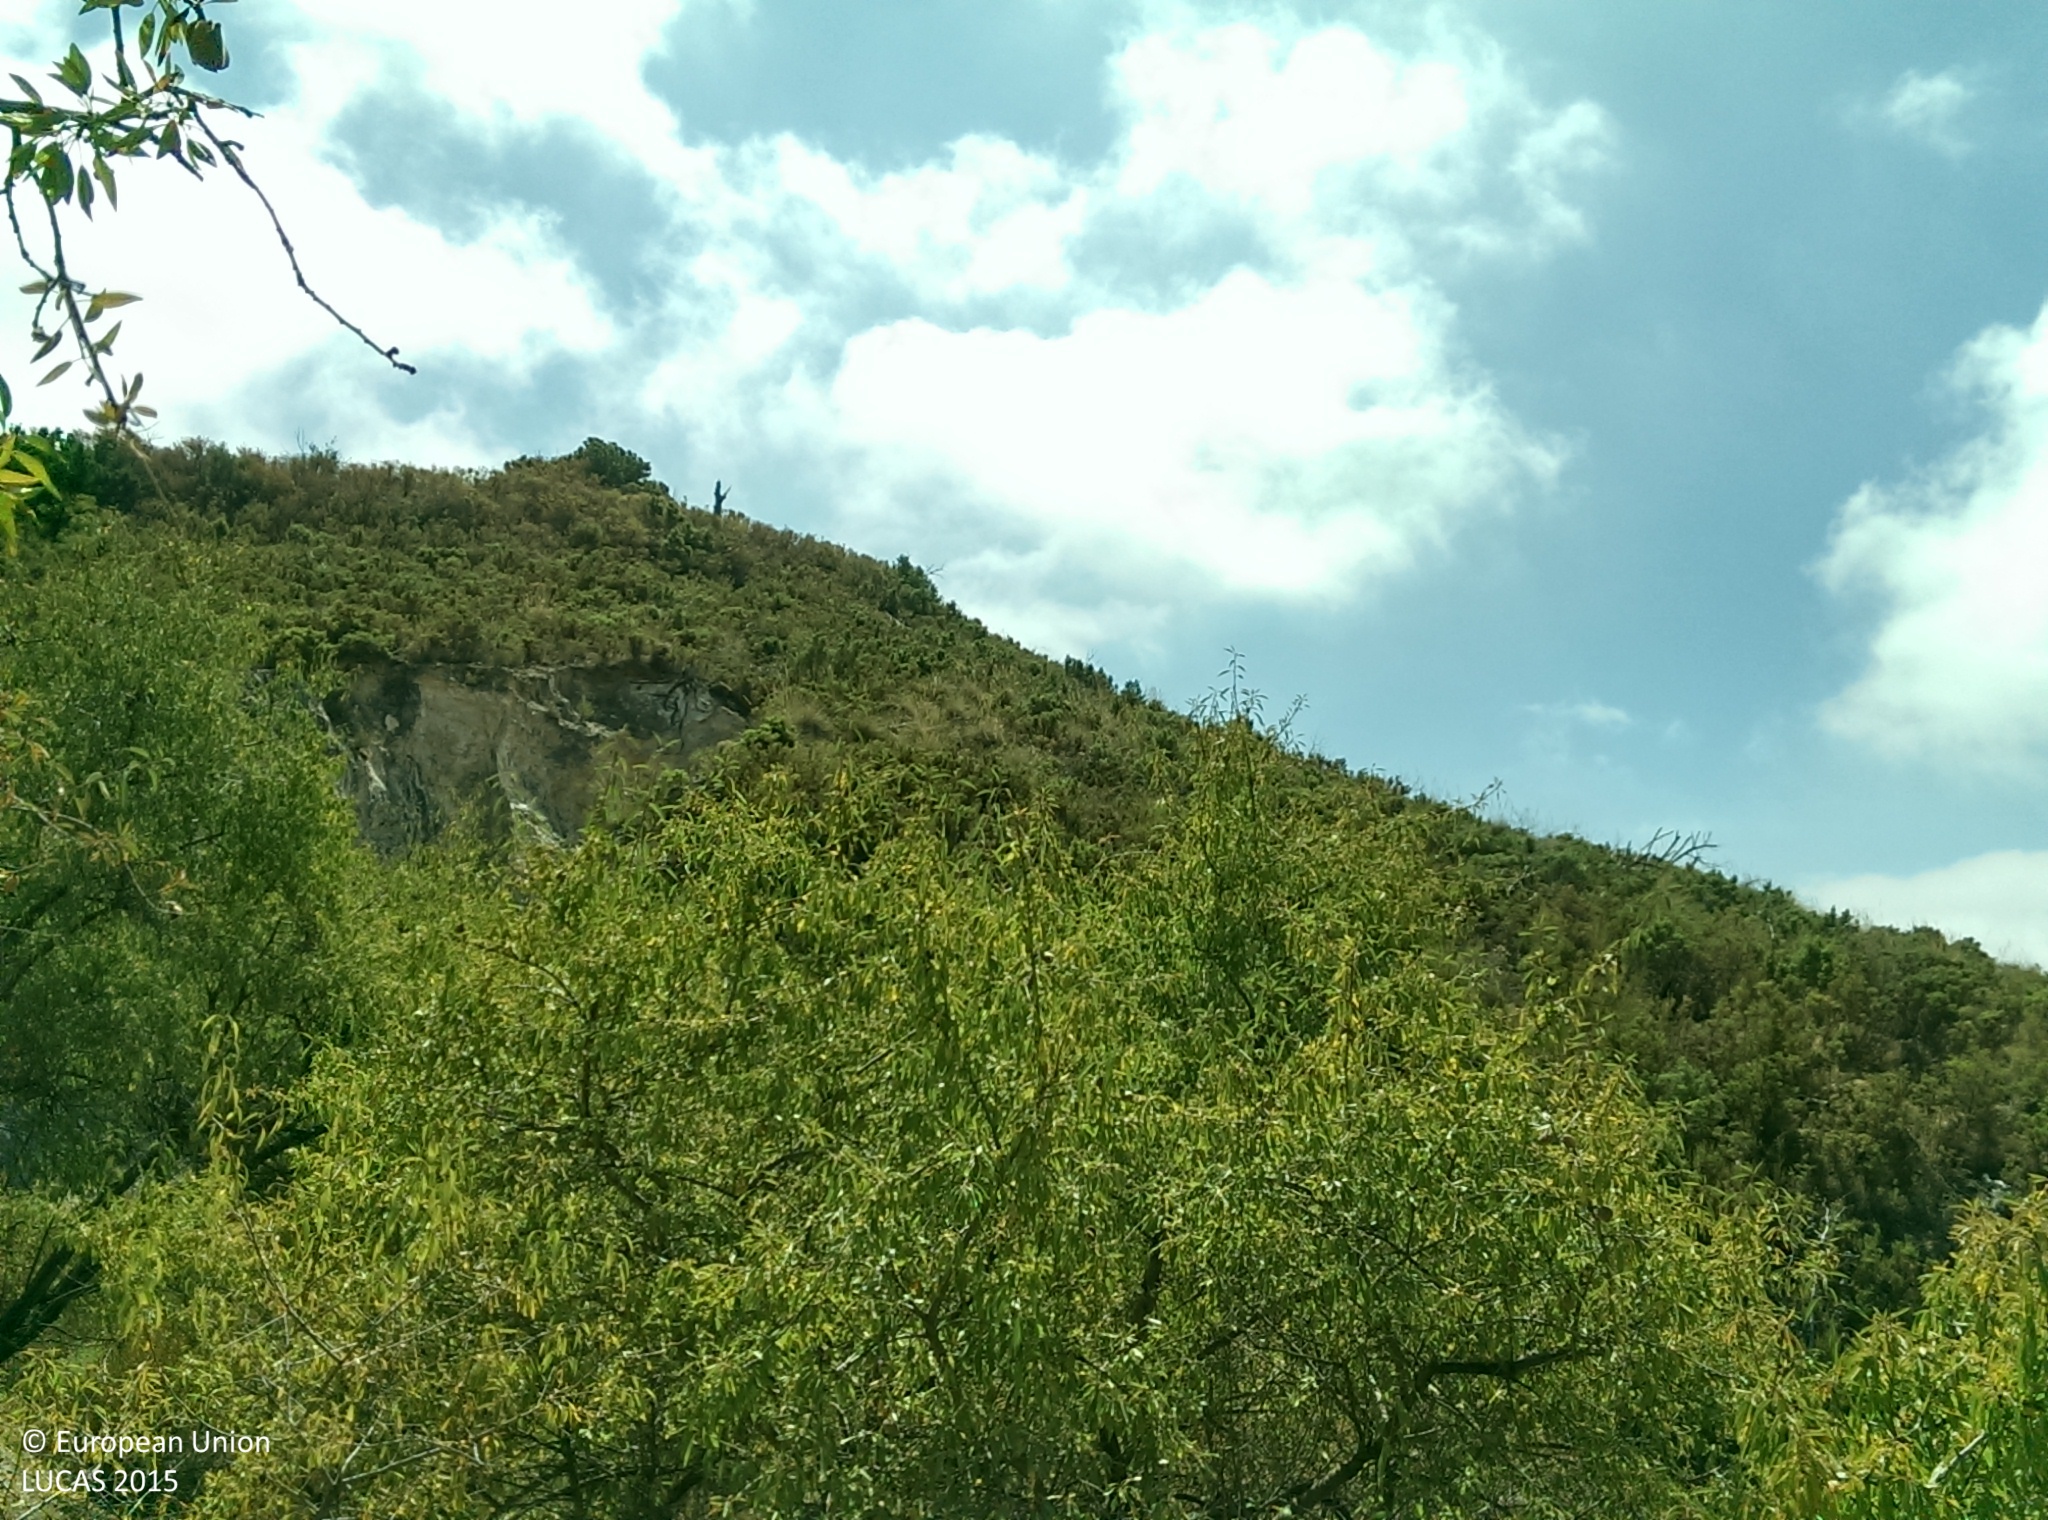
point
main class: Shrubland
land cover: Shrubland without tree cover
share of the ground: > 75 %
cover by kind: shrubs 100 %
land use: Abandoned areas
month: August
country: ES
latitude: 36.8168
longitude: -3.6263
